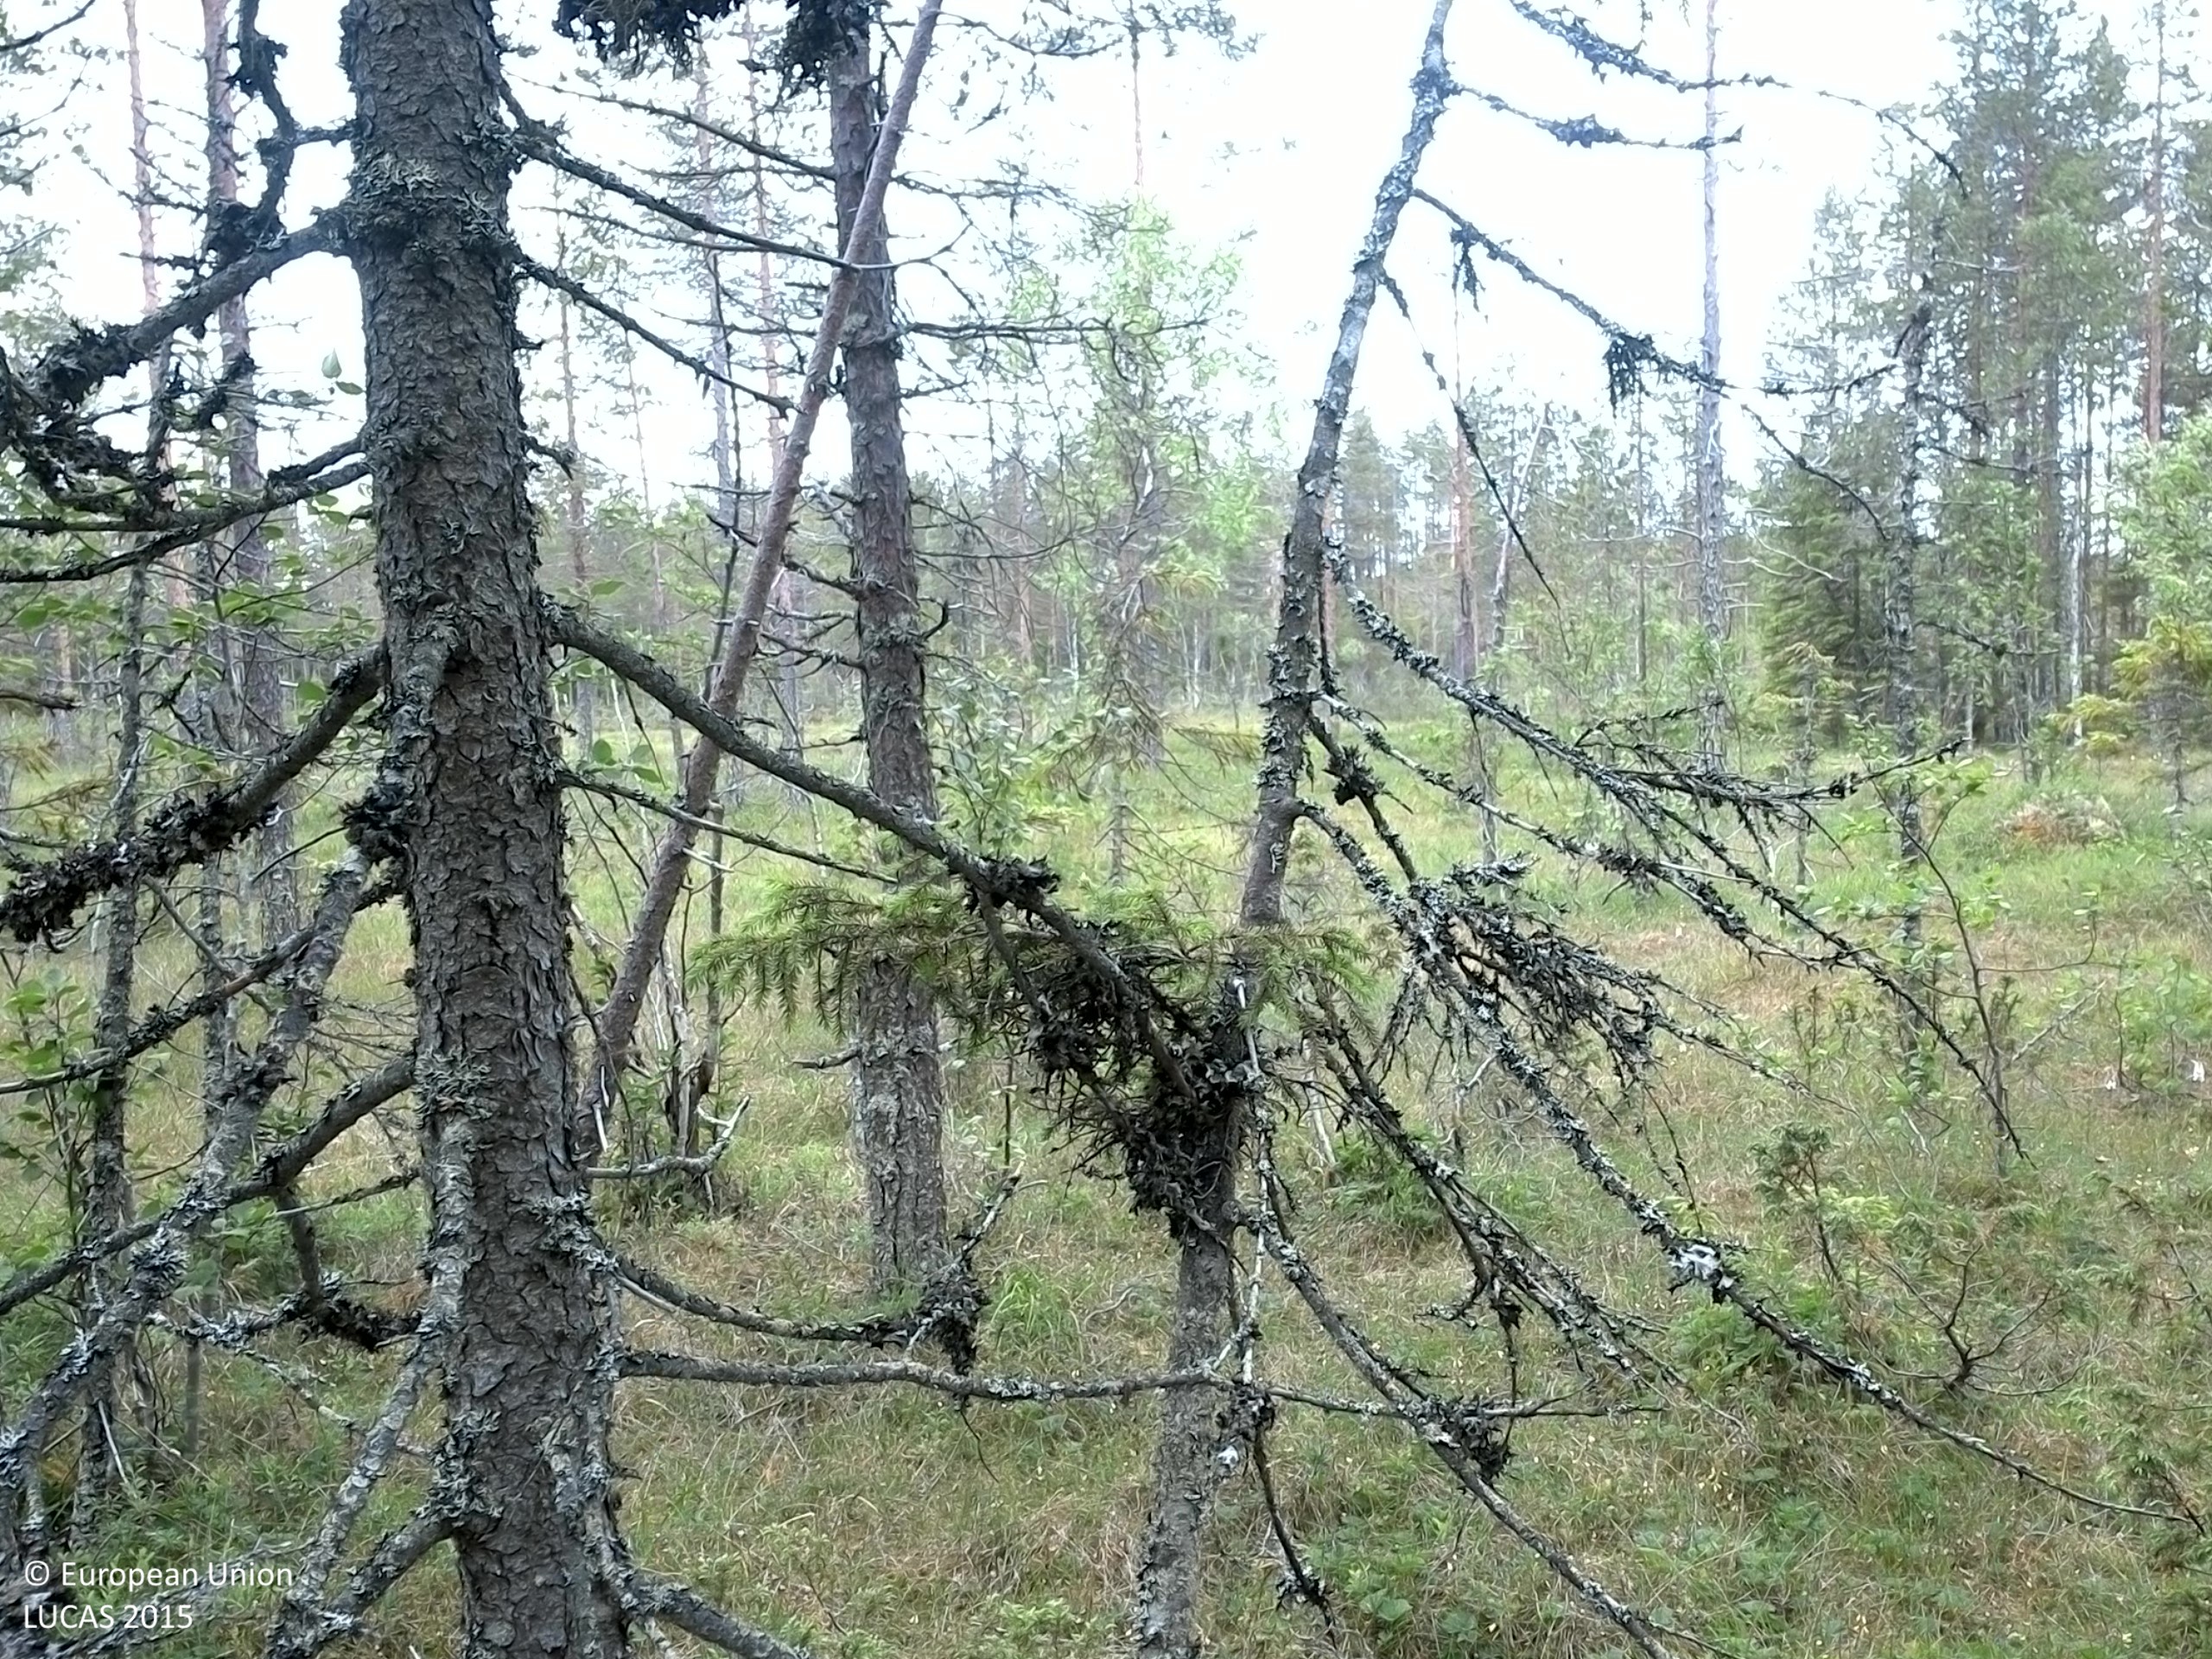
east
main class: Woodland
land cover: Pine dominated coniferous woodland
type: boreal forest
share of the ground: 25 - 50 %
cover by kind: lichens and mosses 55 %, coniferous forest trees 25 %, shrubs 10 %, broadleaved forest trees 5 %, herbaceous plants 5 %
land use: Semi-natural and natural areas not in use
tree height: > 5 m
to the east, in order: Pine dominated coniferous woodland; Pine dominated mixed woodland; Ditches and canals; Pine dominated mixed woodland; Pine dominated coniferous woodland; Shrubland with sparse tree cover; Spruce dominated mixed woodland; Grassland with sparse tree/shrub cover
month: July
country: SE
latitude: 63.5954
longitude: 18.7031
